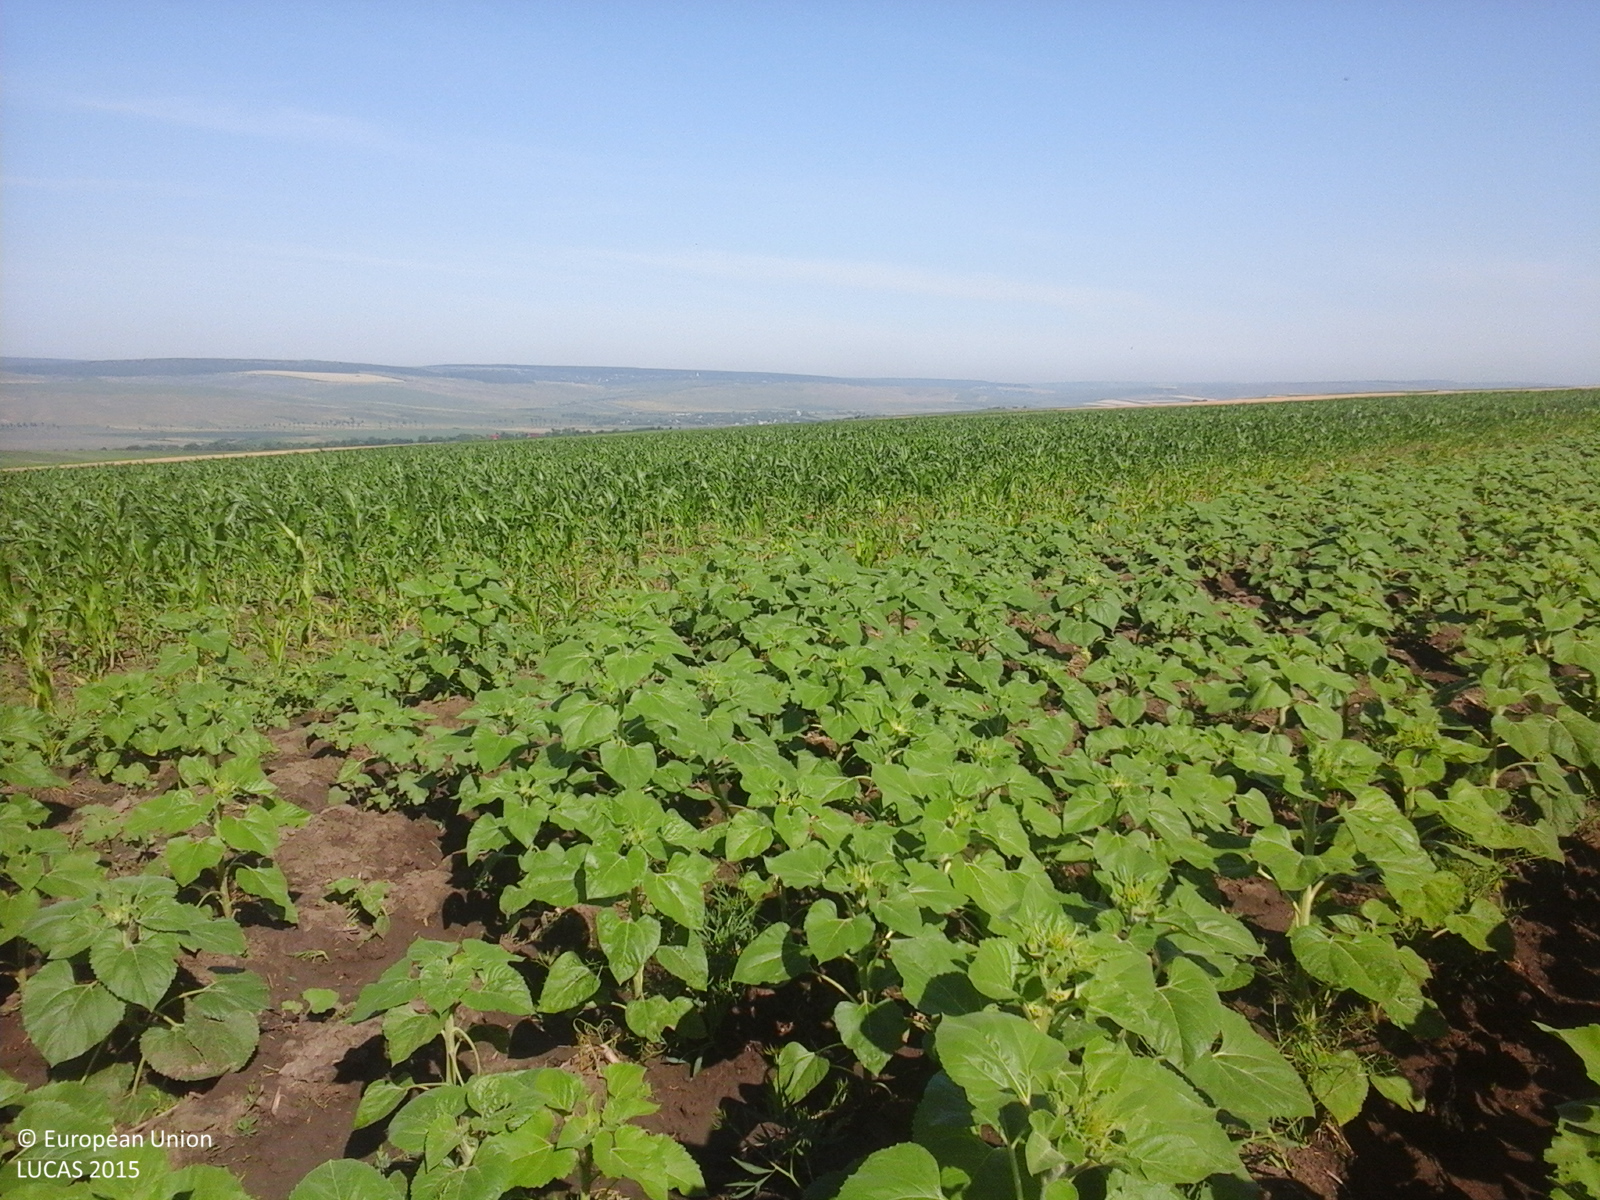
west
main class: Cropland
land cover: Sunflower
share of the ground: 50 - 75 %
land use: Agriculture (excluding fallow land and kitchen gardens)
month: June
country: RO
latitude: 47.7020
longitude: 27.0984
